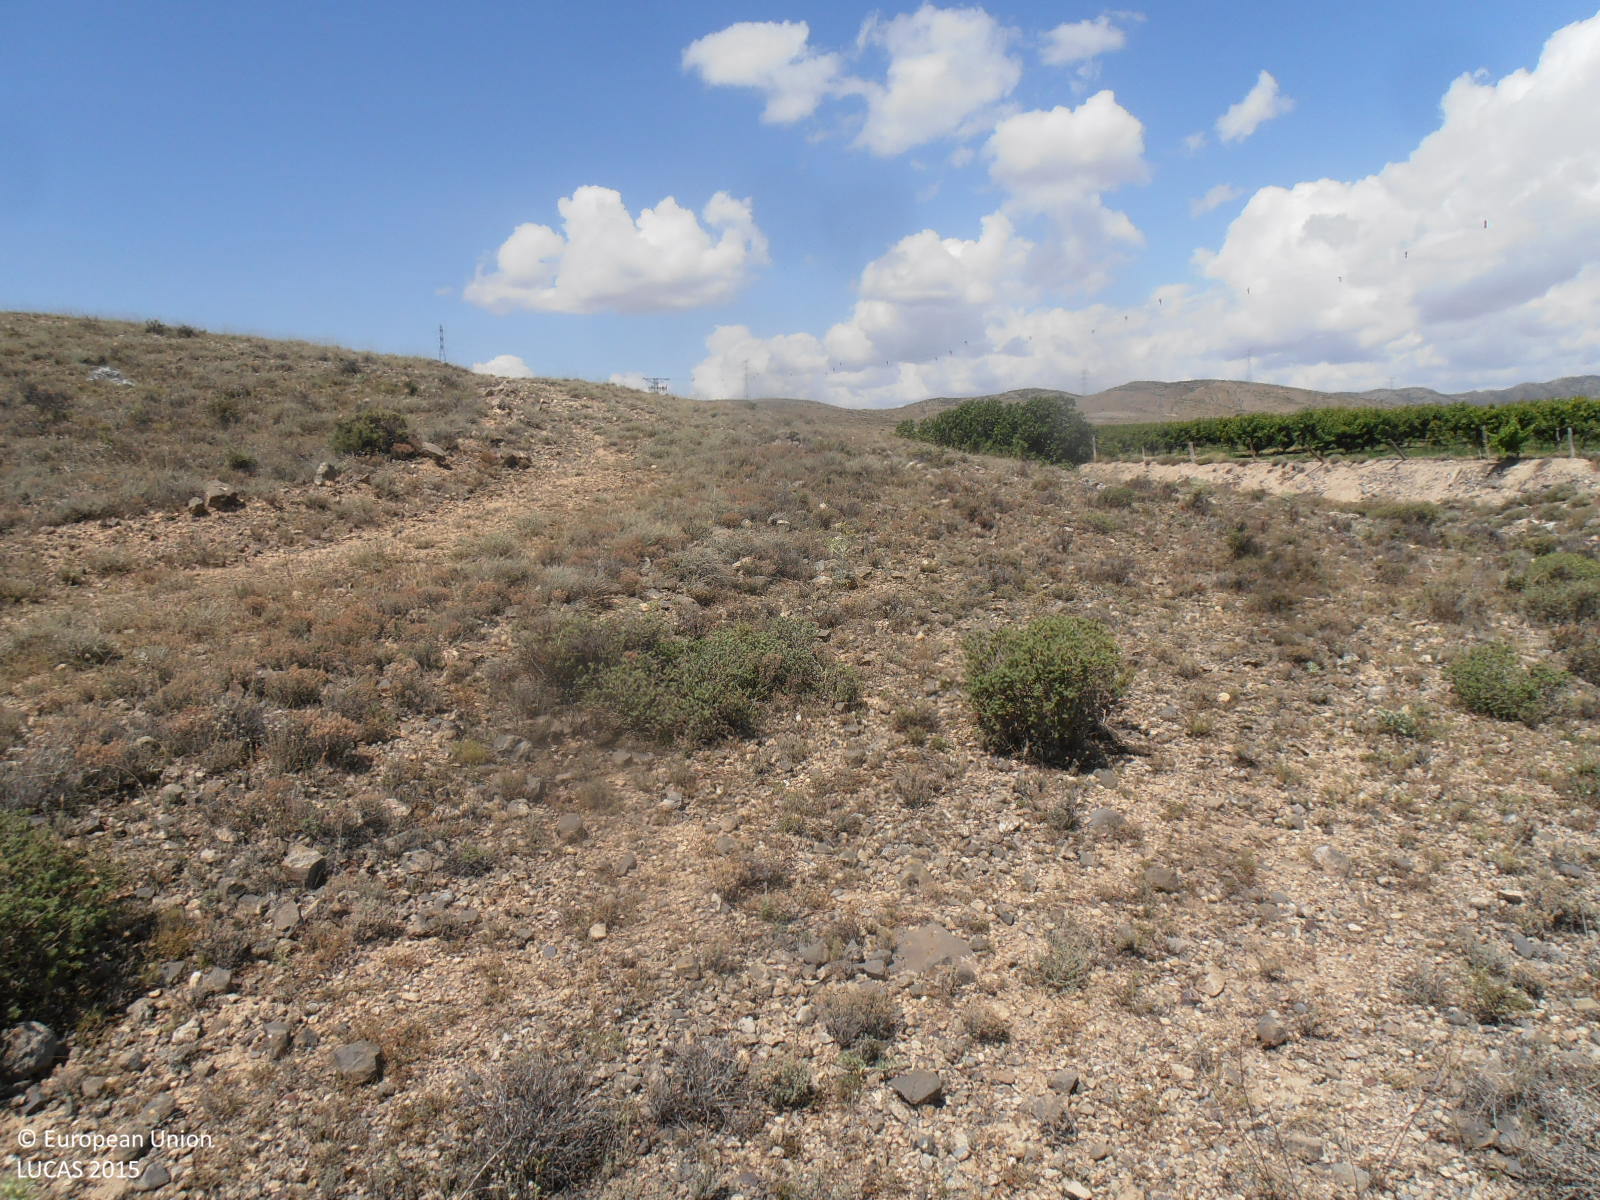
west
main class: Shrubland
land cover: Shrubland without tree cover
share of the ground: 25 - 50 %
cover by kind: consolidated bare surface 55 %, shrubs 40 %, herbaceous plants 5 %
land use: Semi-natural and natural areas not in use
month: June
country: ES
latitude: 41.5138
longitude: -1.4198
